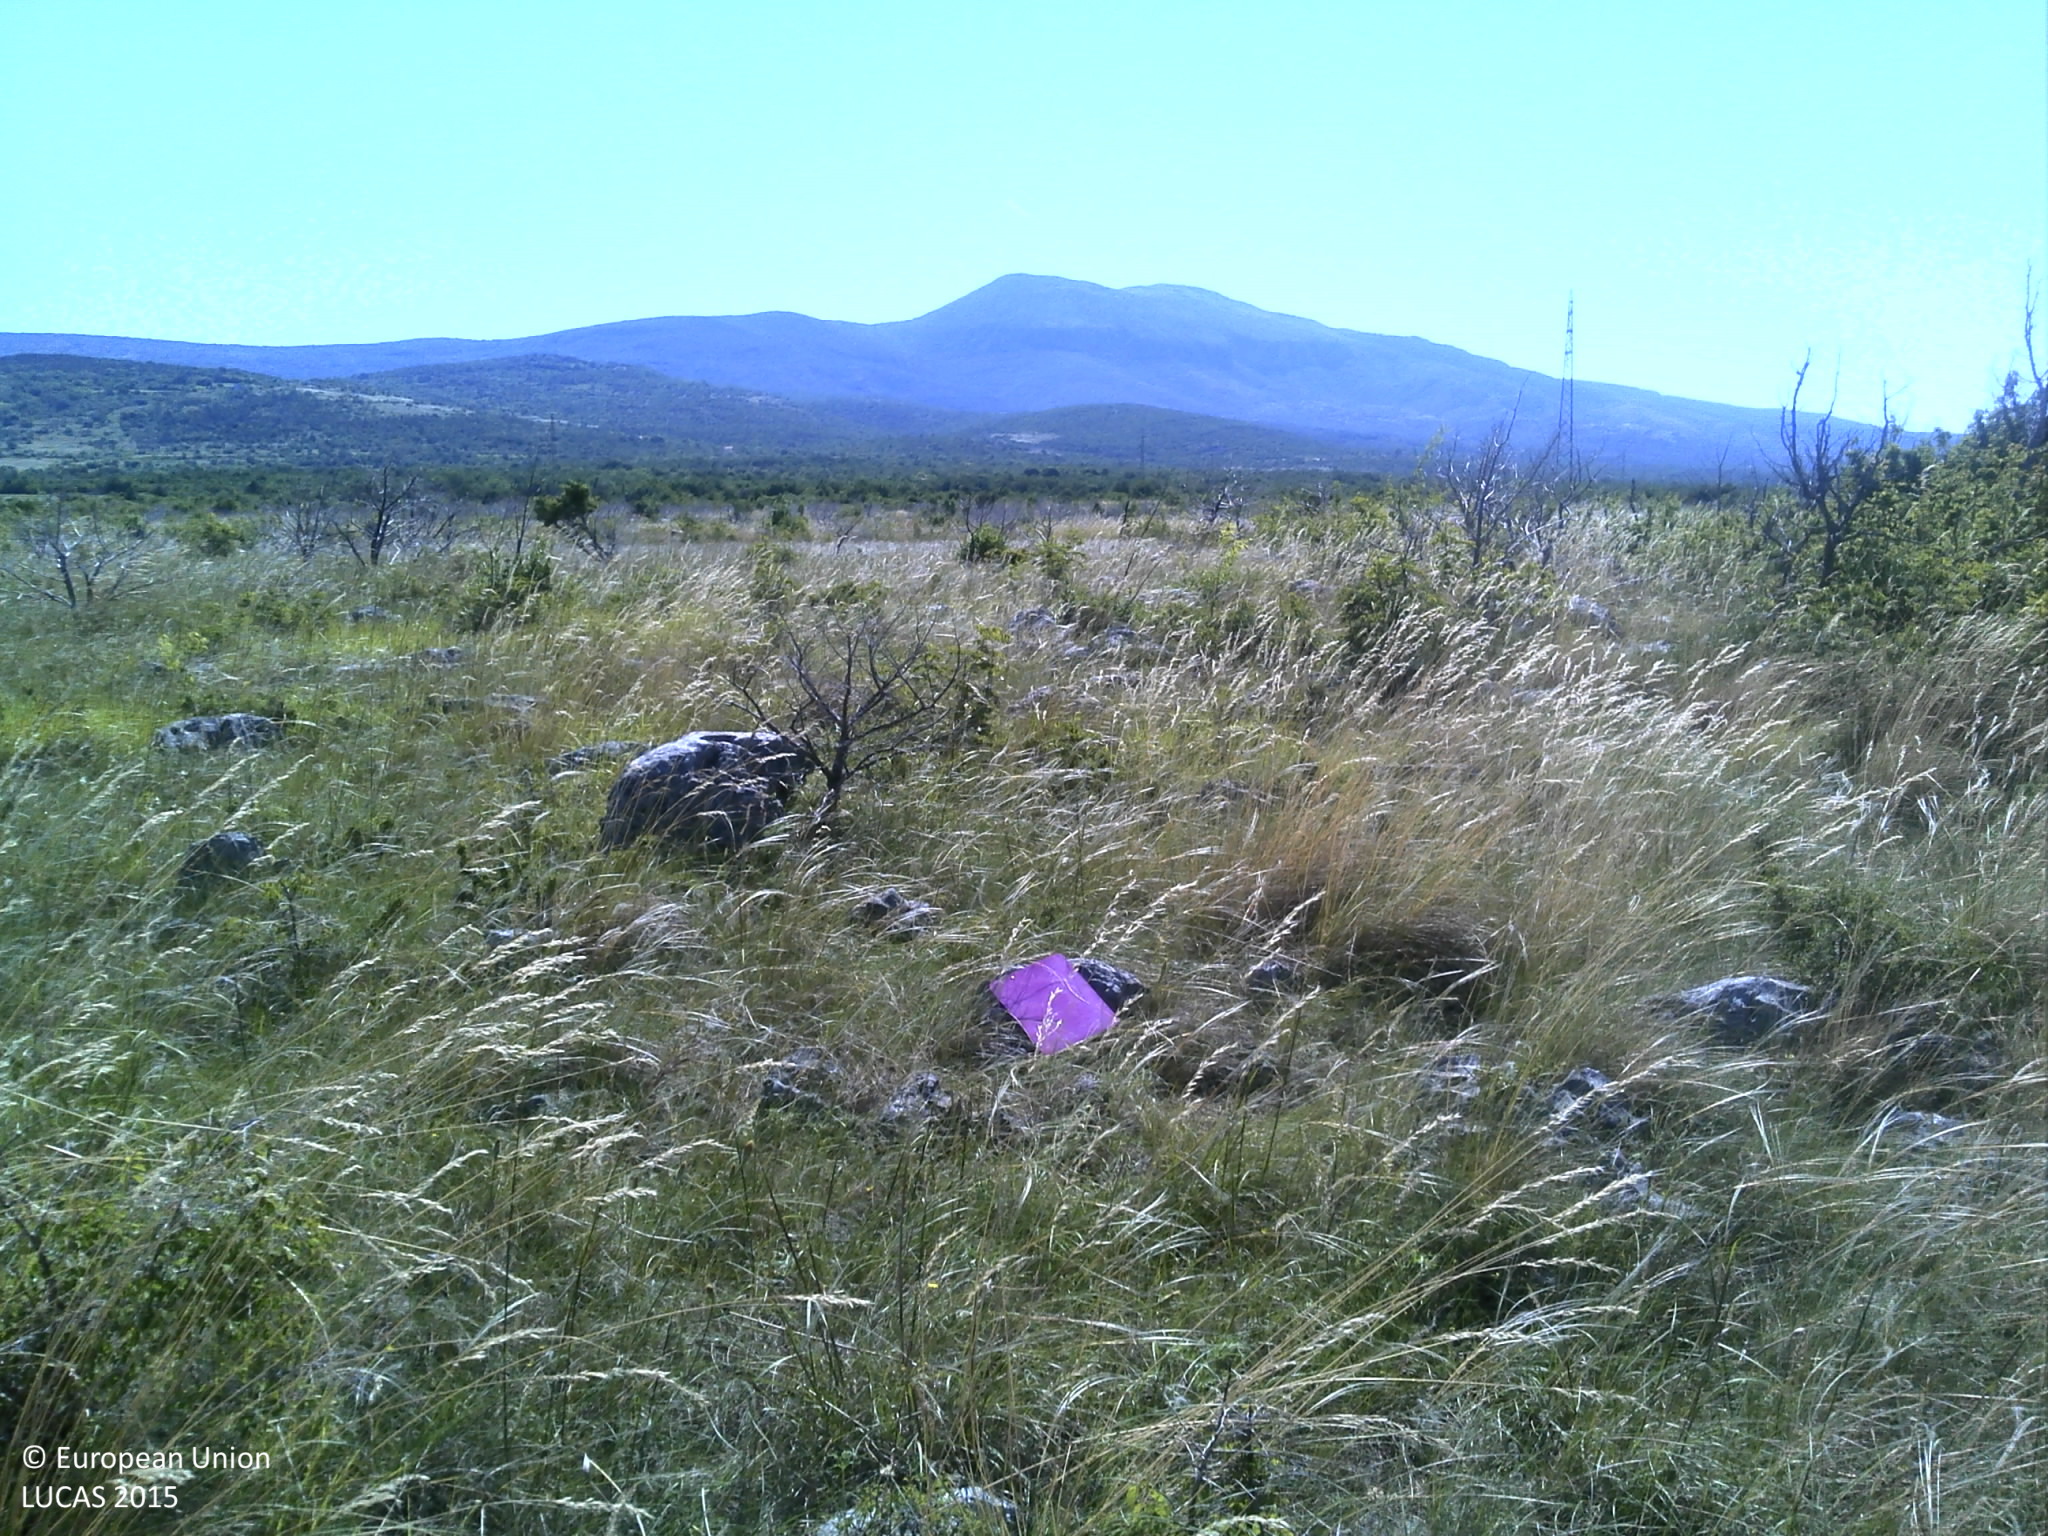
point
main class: Grassland
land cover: Grassland without tree/shrub cover
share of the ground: > 75 %
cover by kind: herbaceous plants 85 %, unconsolidated bare surface 10 %, shrubs 5 %
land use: Semi-natural and natural areas not in use
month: May
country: HR
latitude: 43.9549
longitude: 16.0857
